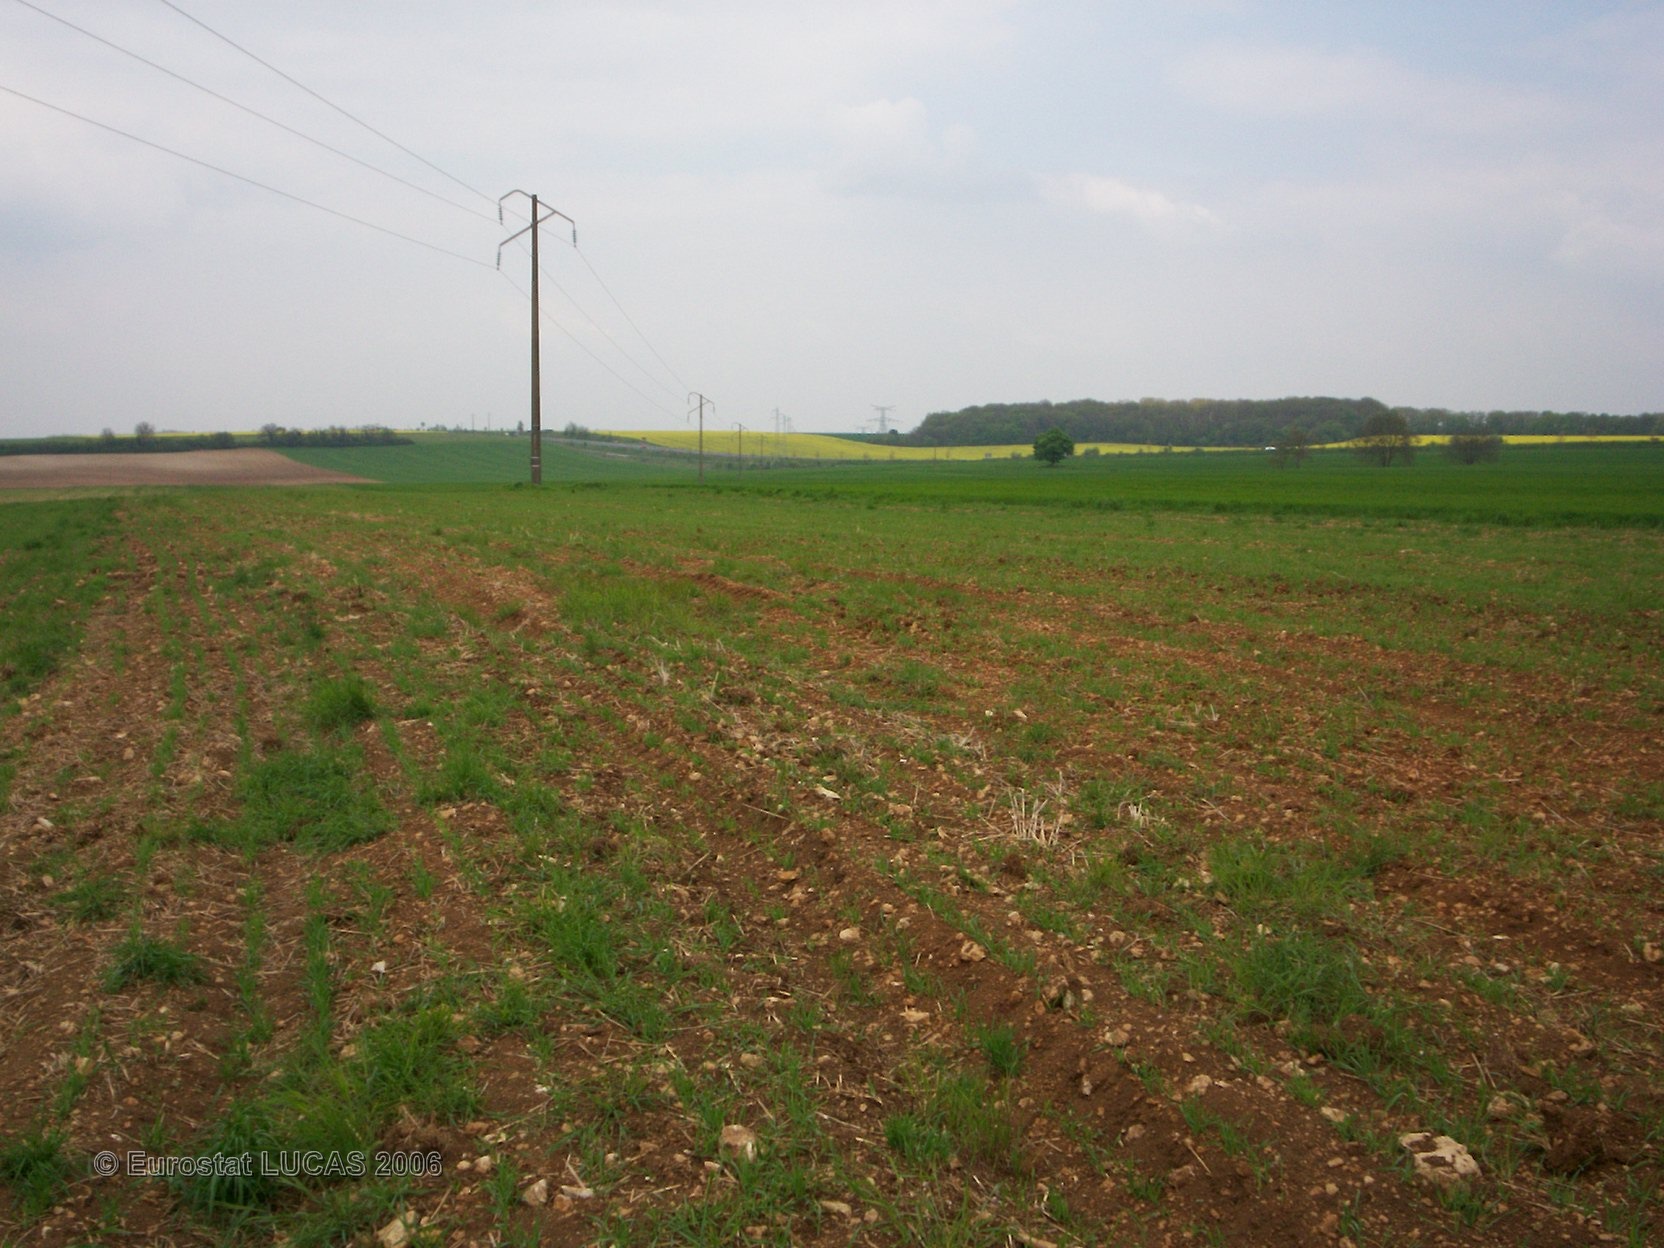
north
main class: Cropland
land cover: Barley
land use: Agriculture (excluding fallow land and kitchen gardens)
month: April
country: FR
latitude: 47.1189
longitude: 3.0495
